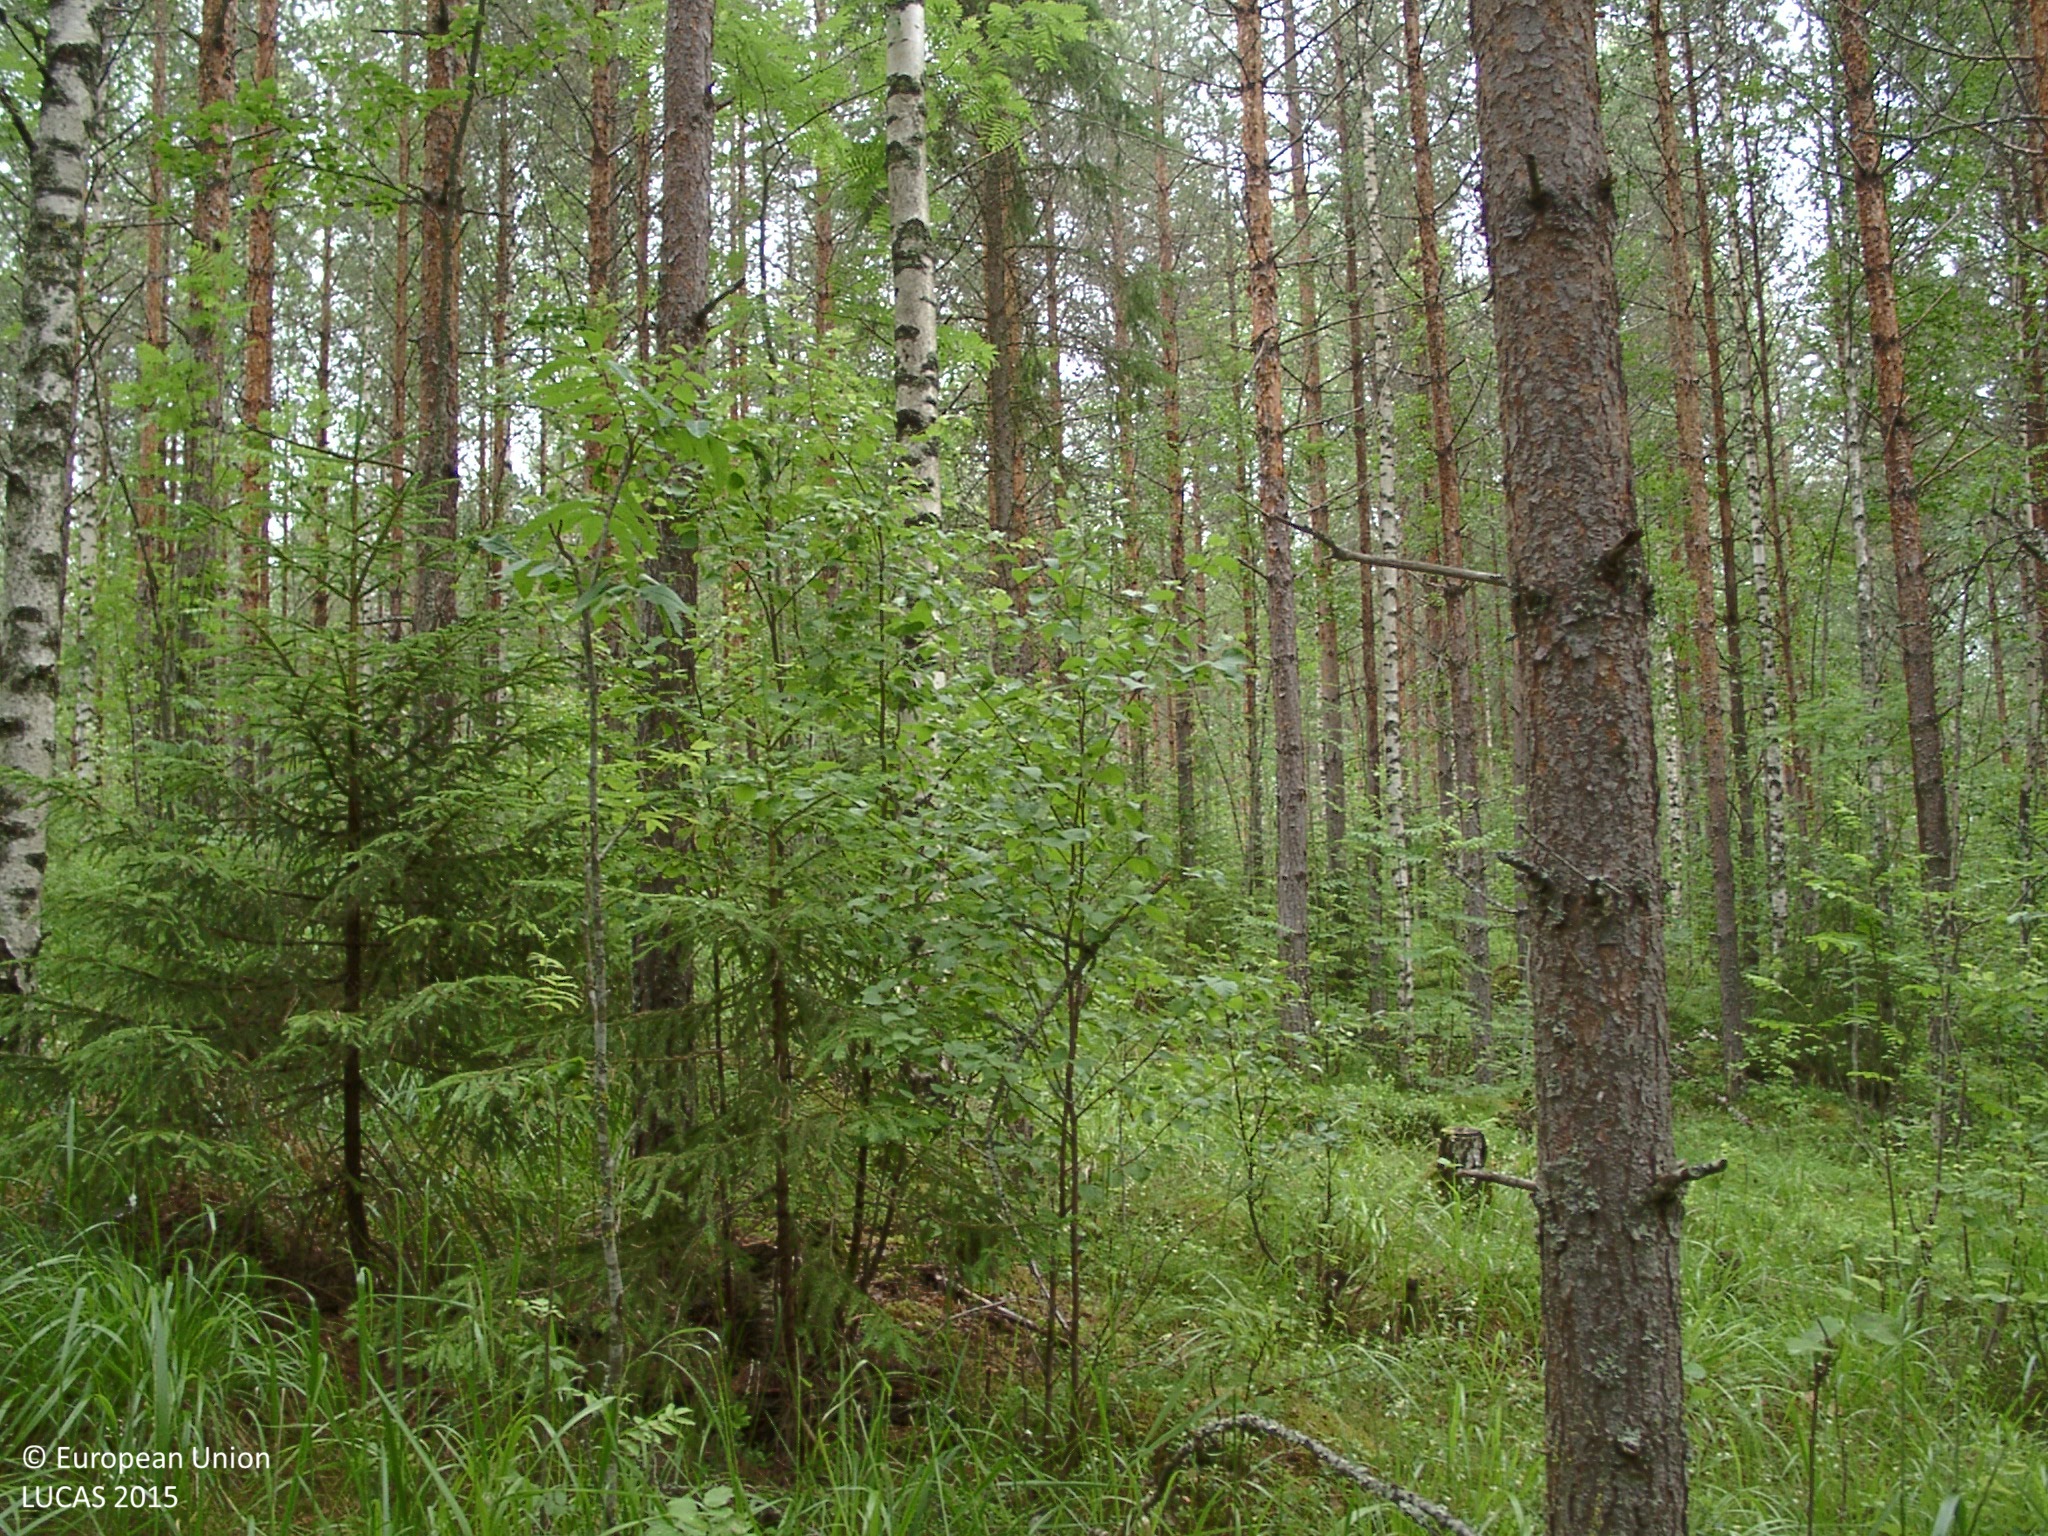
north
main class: Woodland
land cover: Pine dominated mixed woodland
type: boreal forest
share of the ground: 50 - 75 %
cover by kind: coniferous forest trees 45 %, broadleaved forest trees 25 %, shrubs 15 %, herbaceous plants 15 %
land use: Forestry
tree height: > 5 m
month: July
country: FI
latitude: 62.1134
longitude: 25.3481
